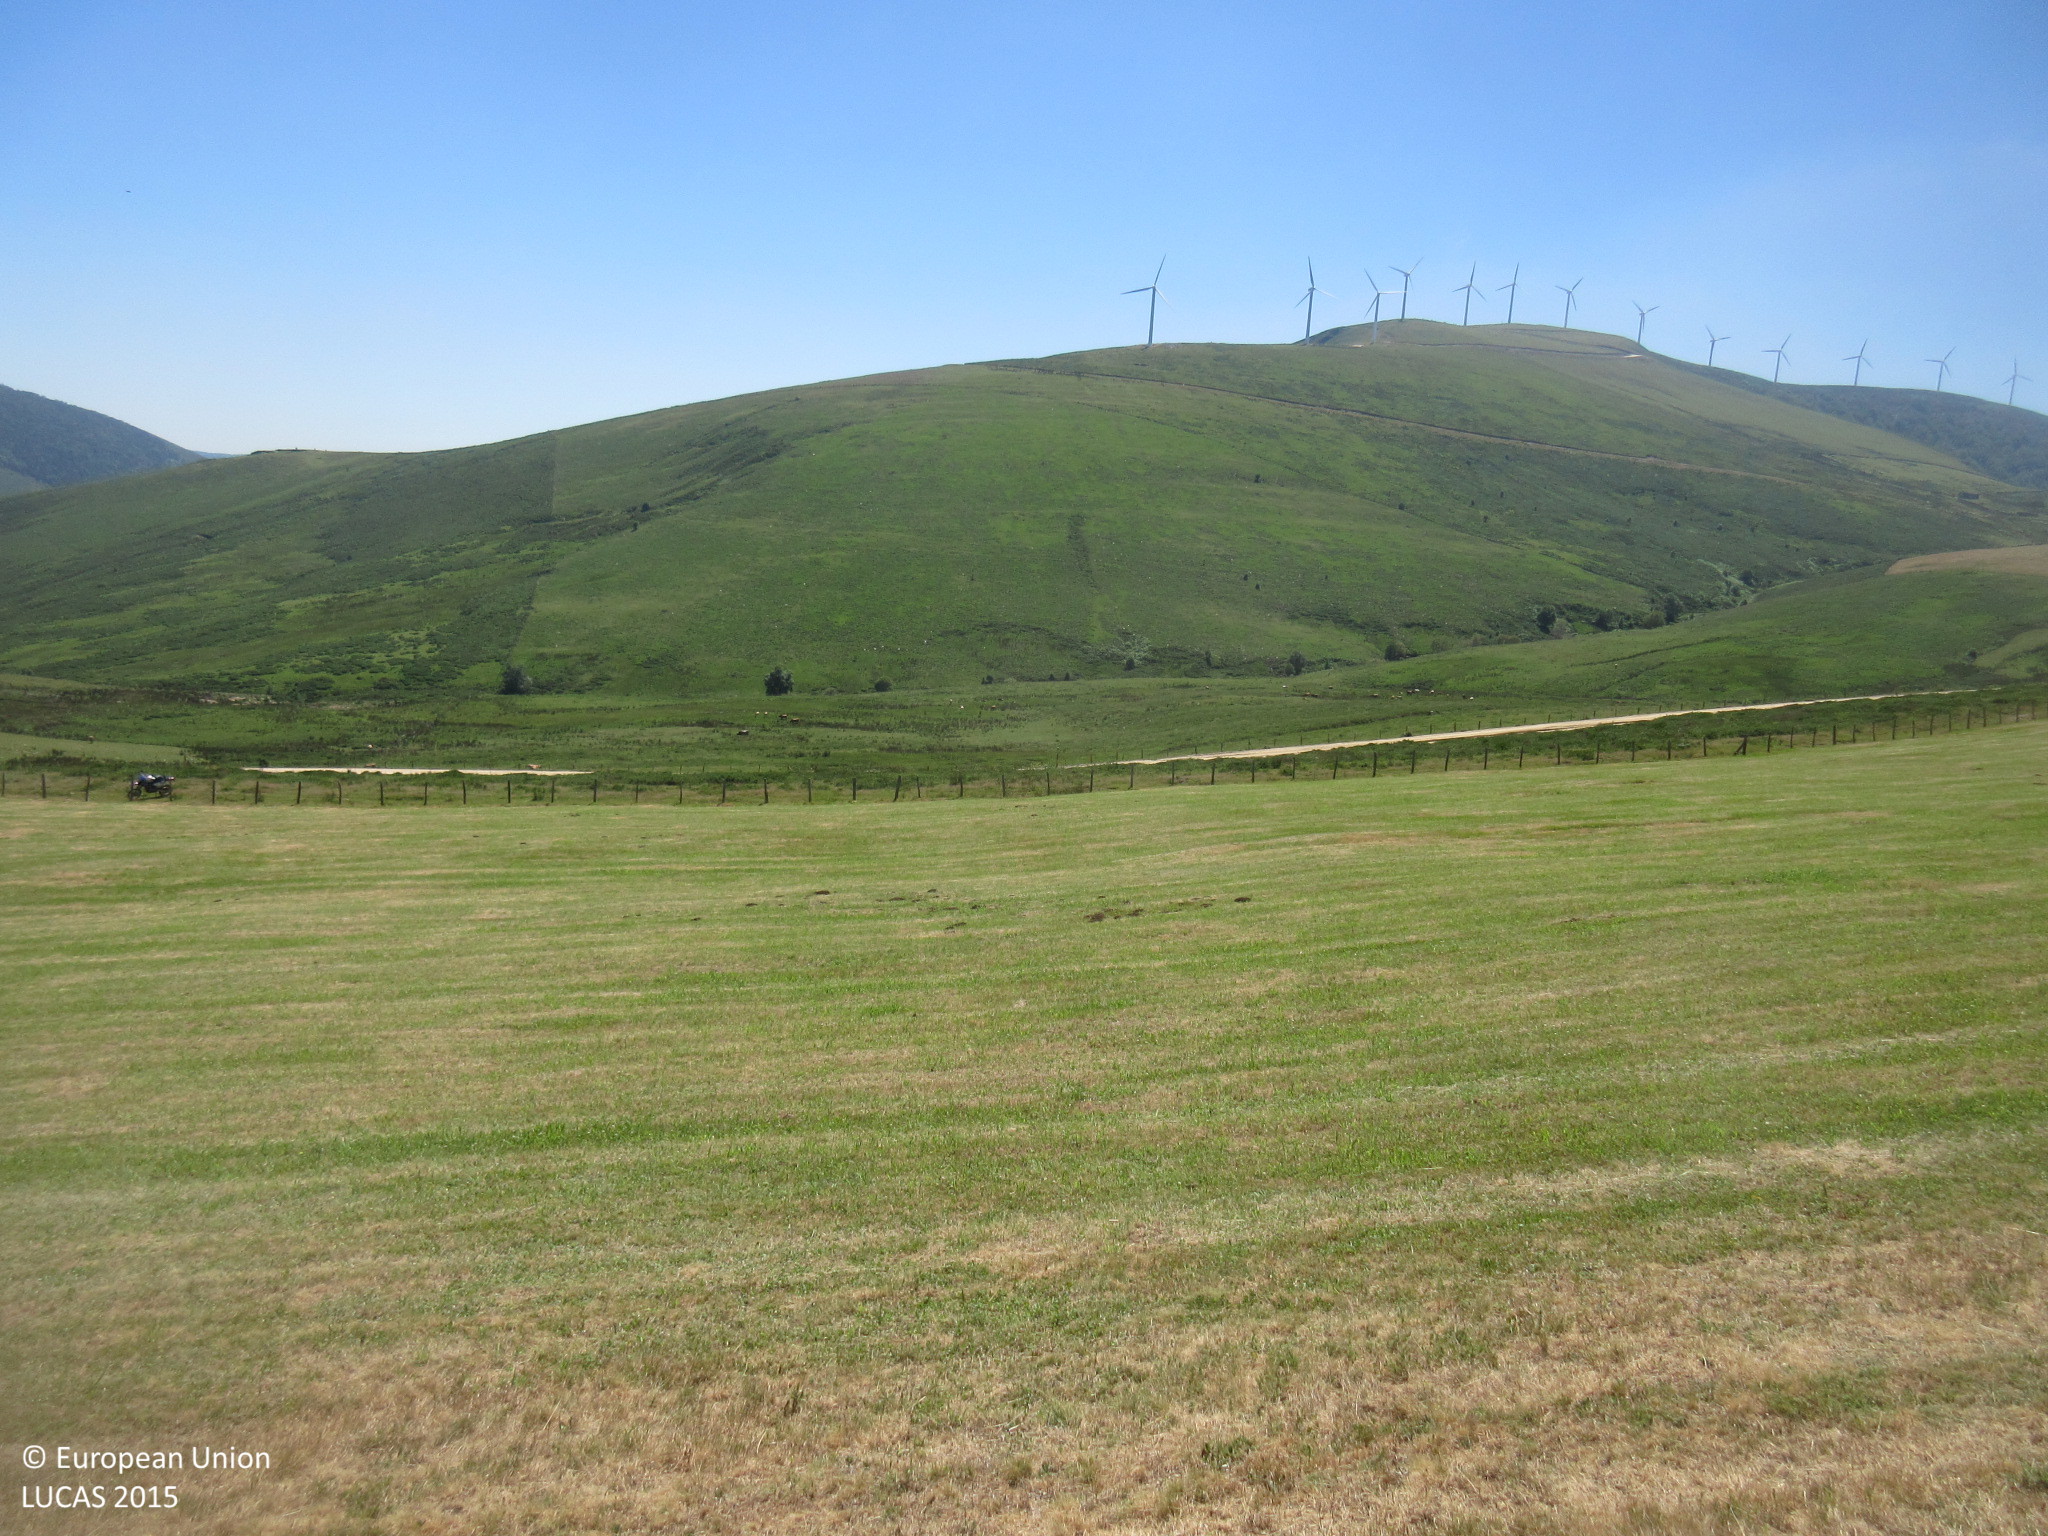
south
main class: Woodland
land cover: Broadleaved woodland
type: mountainous beech forest
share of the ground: > 75 %
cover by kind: broadleaved forest trees 100 %
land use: Semi-natural and natural areas not in use
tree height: > 5 m
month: July
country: ES
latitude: 43.1587
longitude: -3.4584
